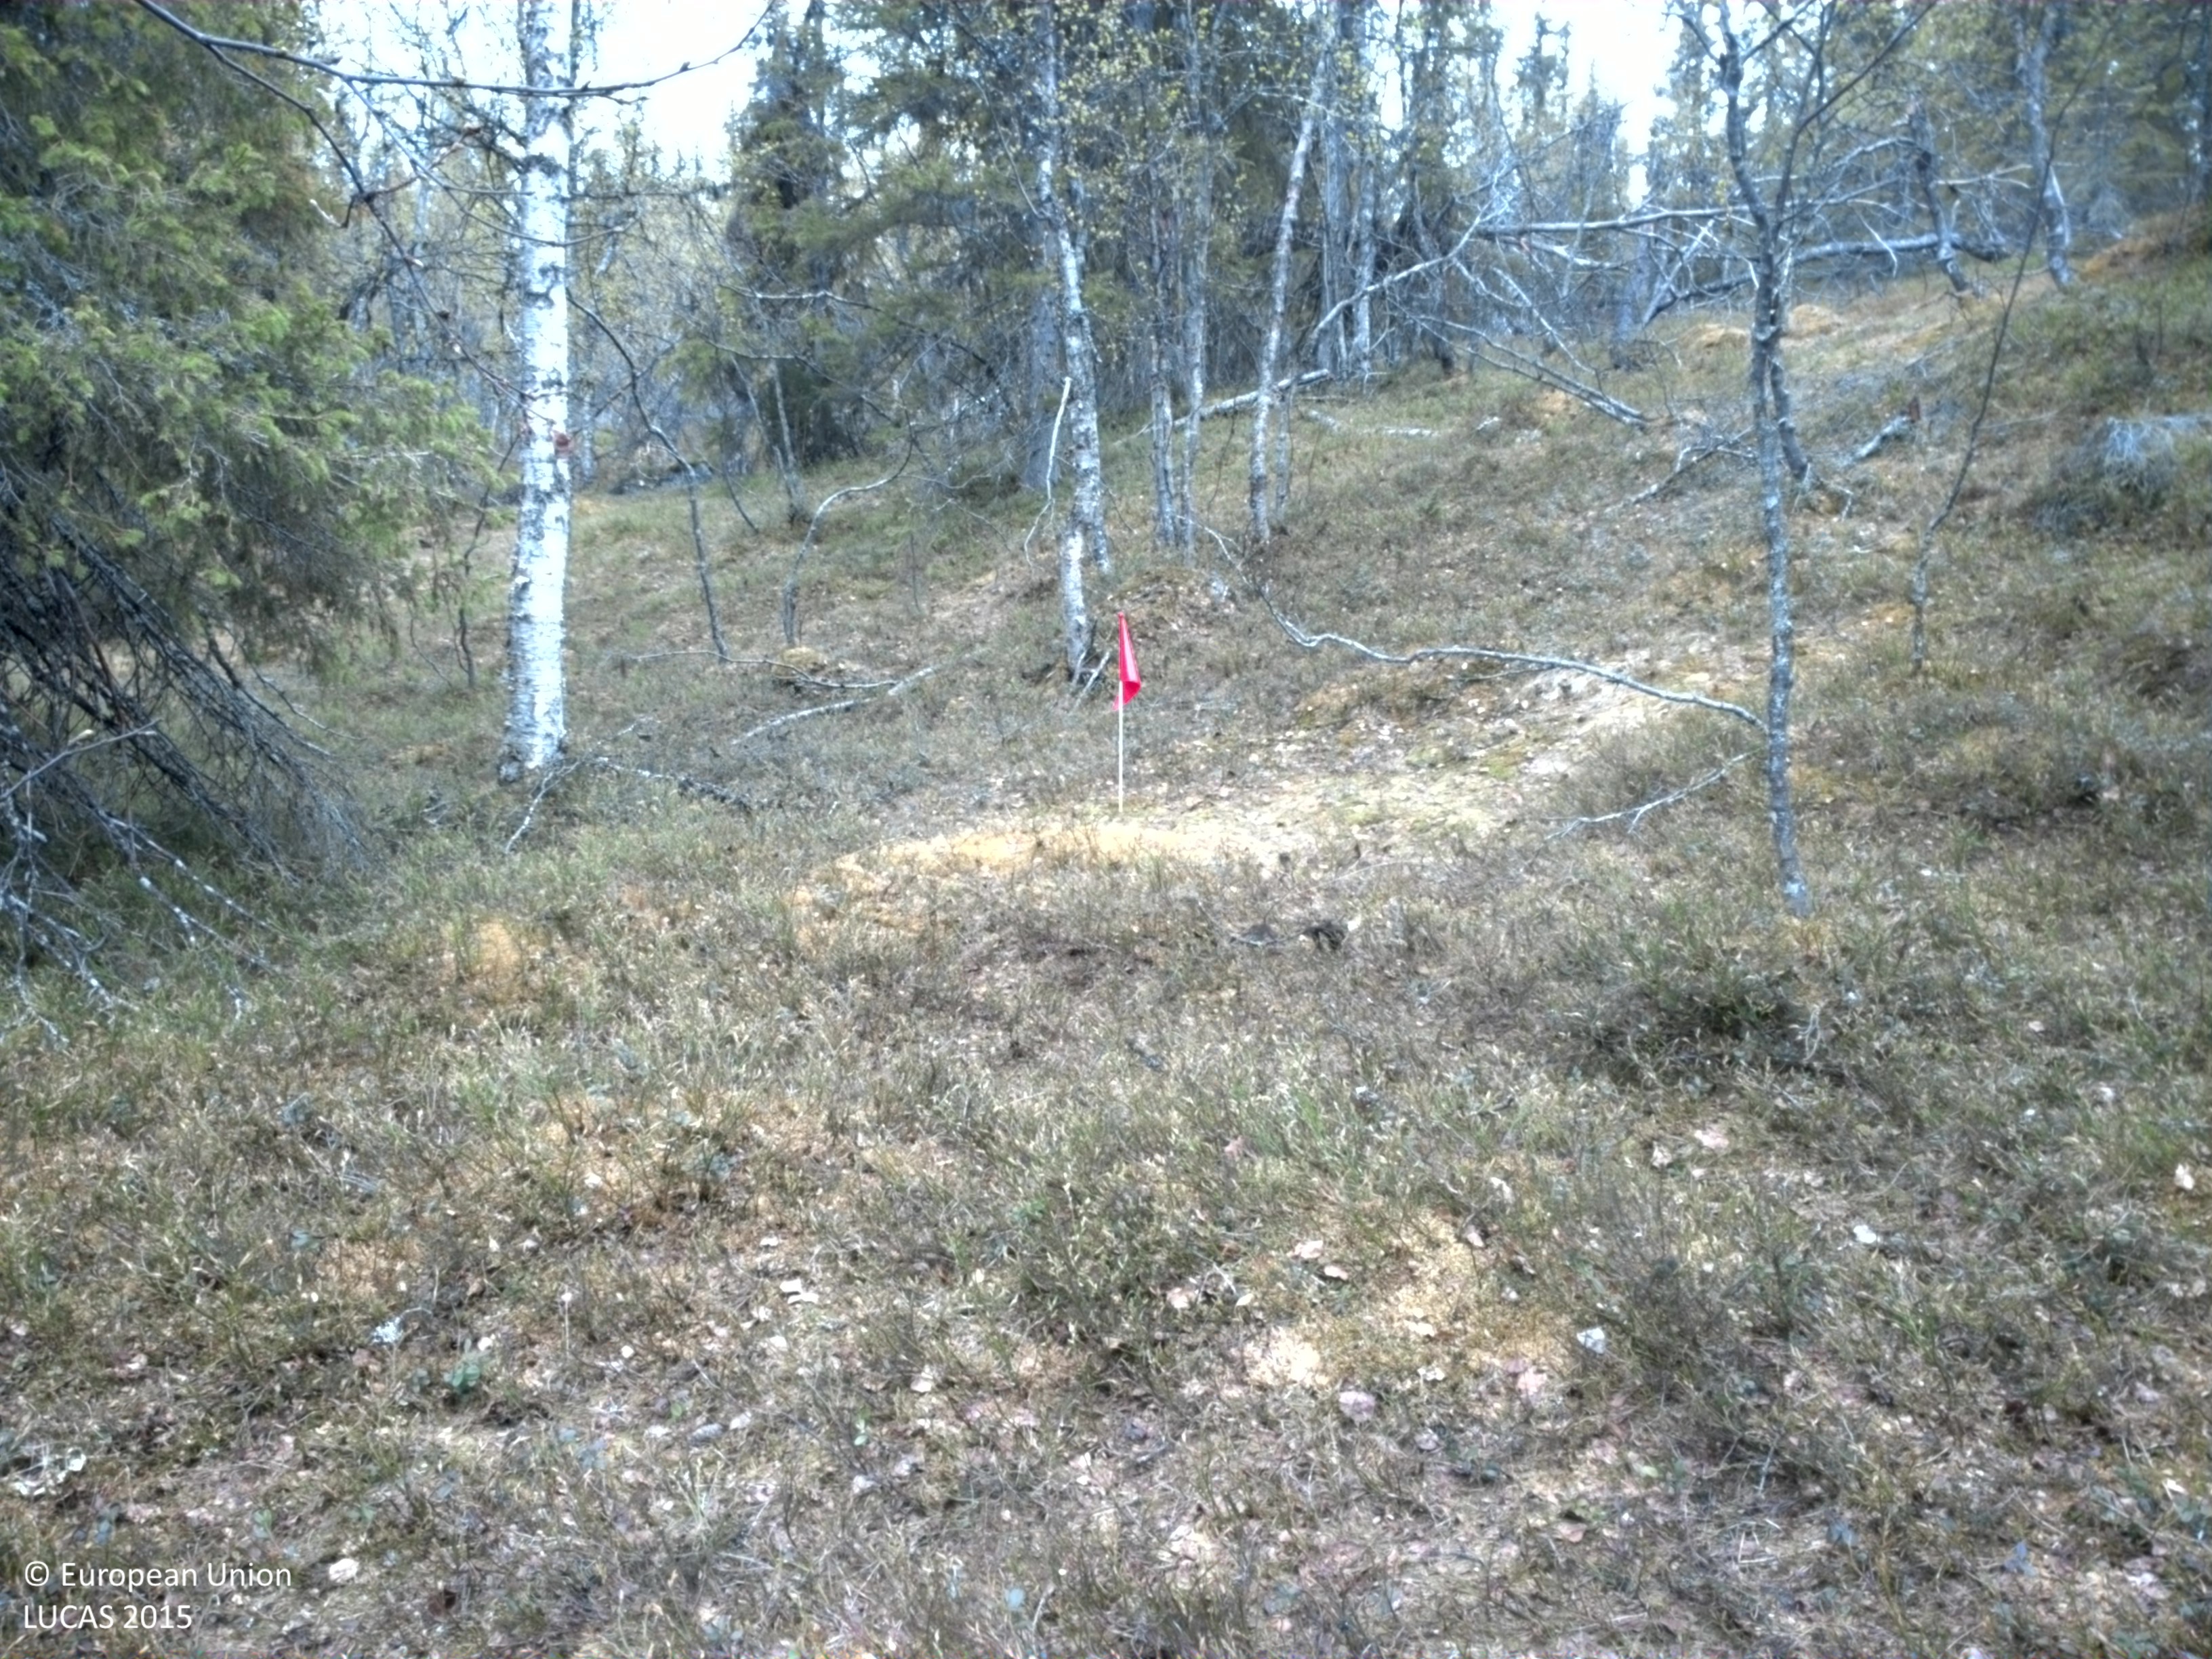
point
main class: Woodland
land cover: Spruce dominated mixed woodland
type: boreal forest
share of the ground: 50 - 75 %
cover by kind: coniferous forest trees 40 %, shrubs 35 %, broadleaved forest trees 25 %
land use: Forestry
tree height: > 5 m
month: June
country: SE
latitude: 66.1851
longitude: 18.9431
